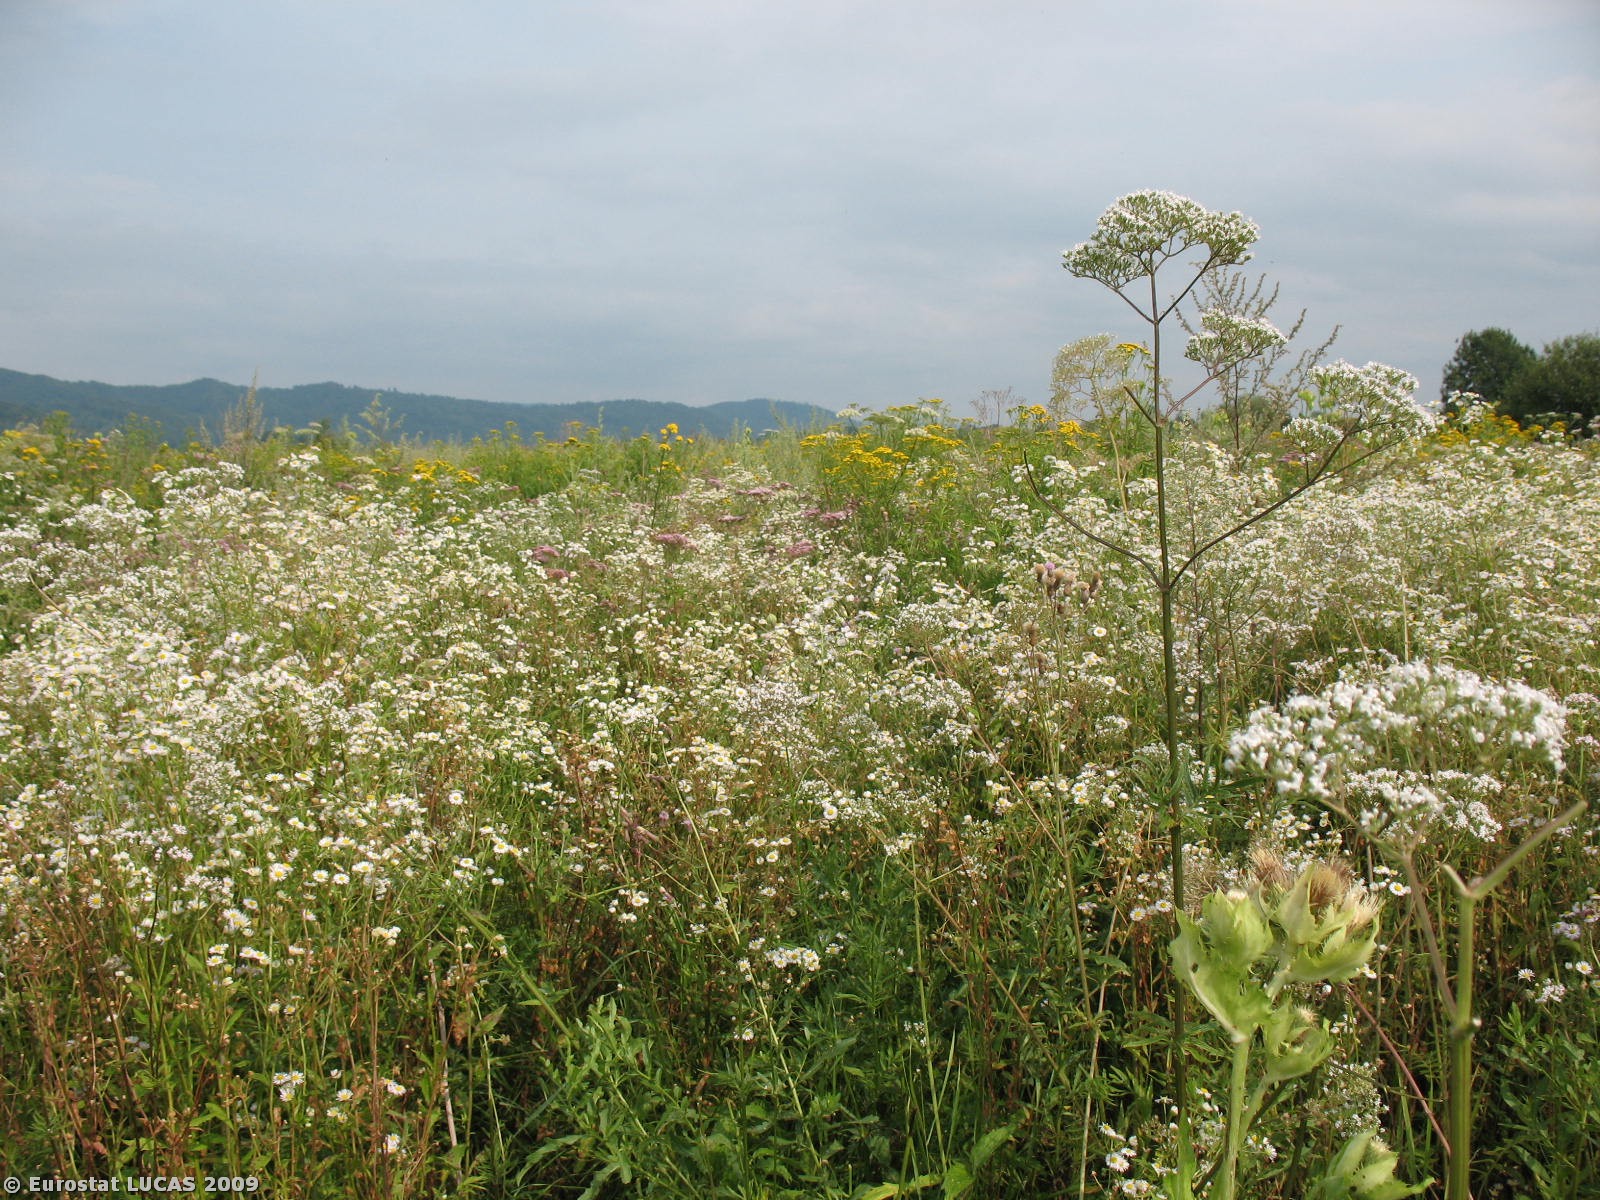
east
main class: Grassland
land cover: Spontaneously vegetated surfaces
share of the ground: > 75 %
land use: Unused
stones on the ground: < 10 %
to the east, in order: Spontaneously vegetated surfaces; Tracks; Spontaneously vegetated surfaces; Grassland without tree/shrub cover; Spontaneously vegetated surfaces; Grassland without tree/shrub cover
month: August
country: PL
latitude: 49.5405
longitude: 22.2352
